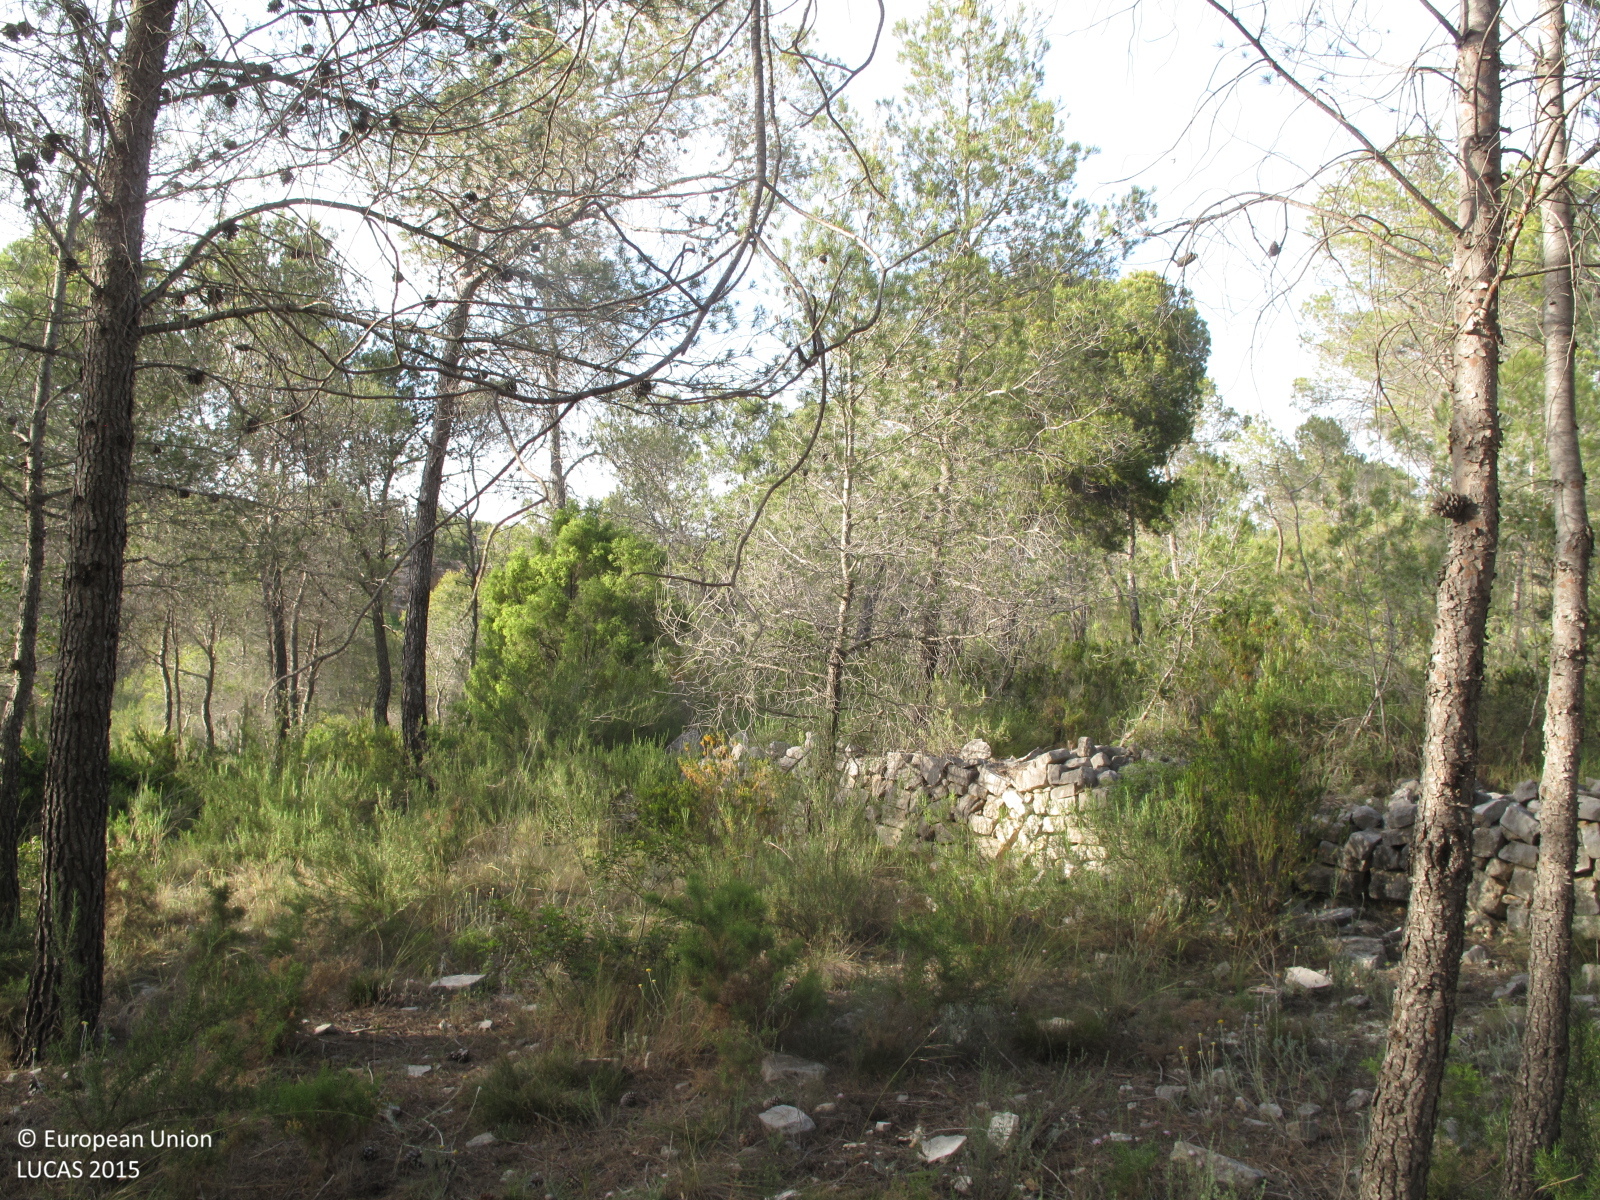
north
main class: Woodland
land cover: Pine dominated coniferous woodland
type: coniferous forest of the mediterranean region
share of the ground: 50 - 75 %
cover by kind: coniferous forest trees 60 %, shrubs 20 %, herbaceous plants 15 %, consolidated bare surface 5 %
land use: Semi-natural and natural areas not in use
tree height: > 5 m
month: May
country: ES
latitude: 39.0542
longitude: -0.7527
